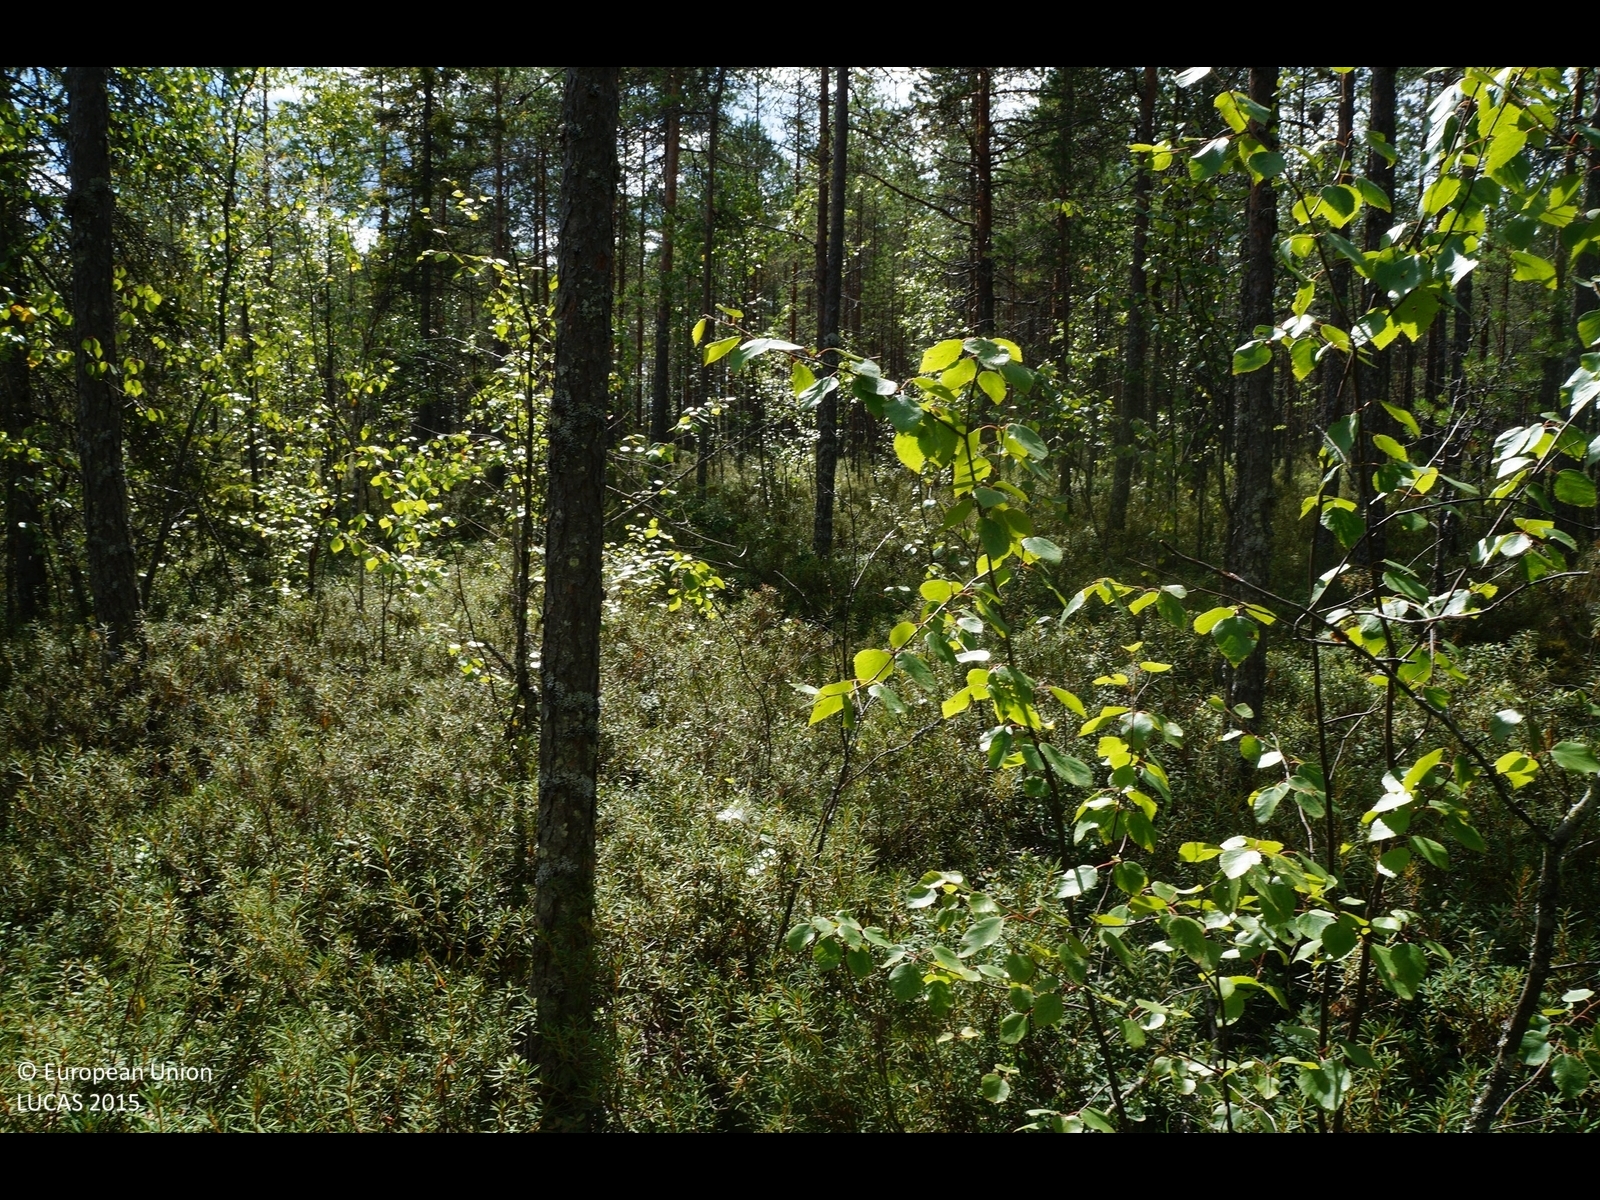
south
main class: Woodland
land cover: Pine dominated coniferous woodland
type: boreal forest
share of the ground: 25 - 50 %
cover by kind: coniferous forest trees 40 %, shrubs 40 %, lichens and mosses 15 %, broadleaved forest trees 5 %
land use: Forestry
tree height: > 5 m
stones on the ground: < 10 %
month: August
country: FI
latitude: 64.4446
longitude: 26.0389
